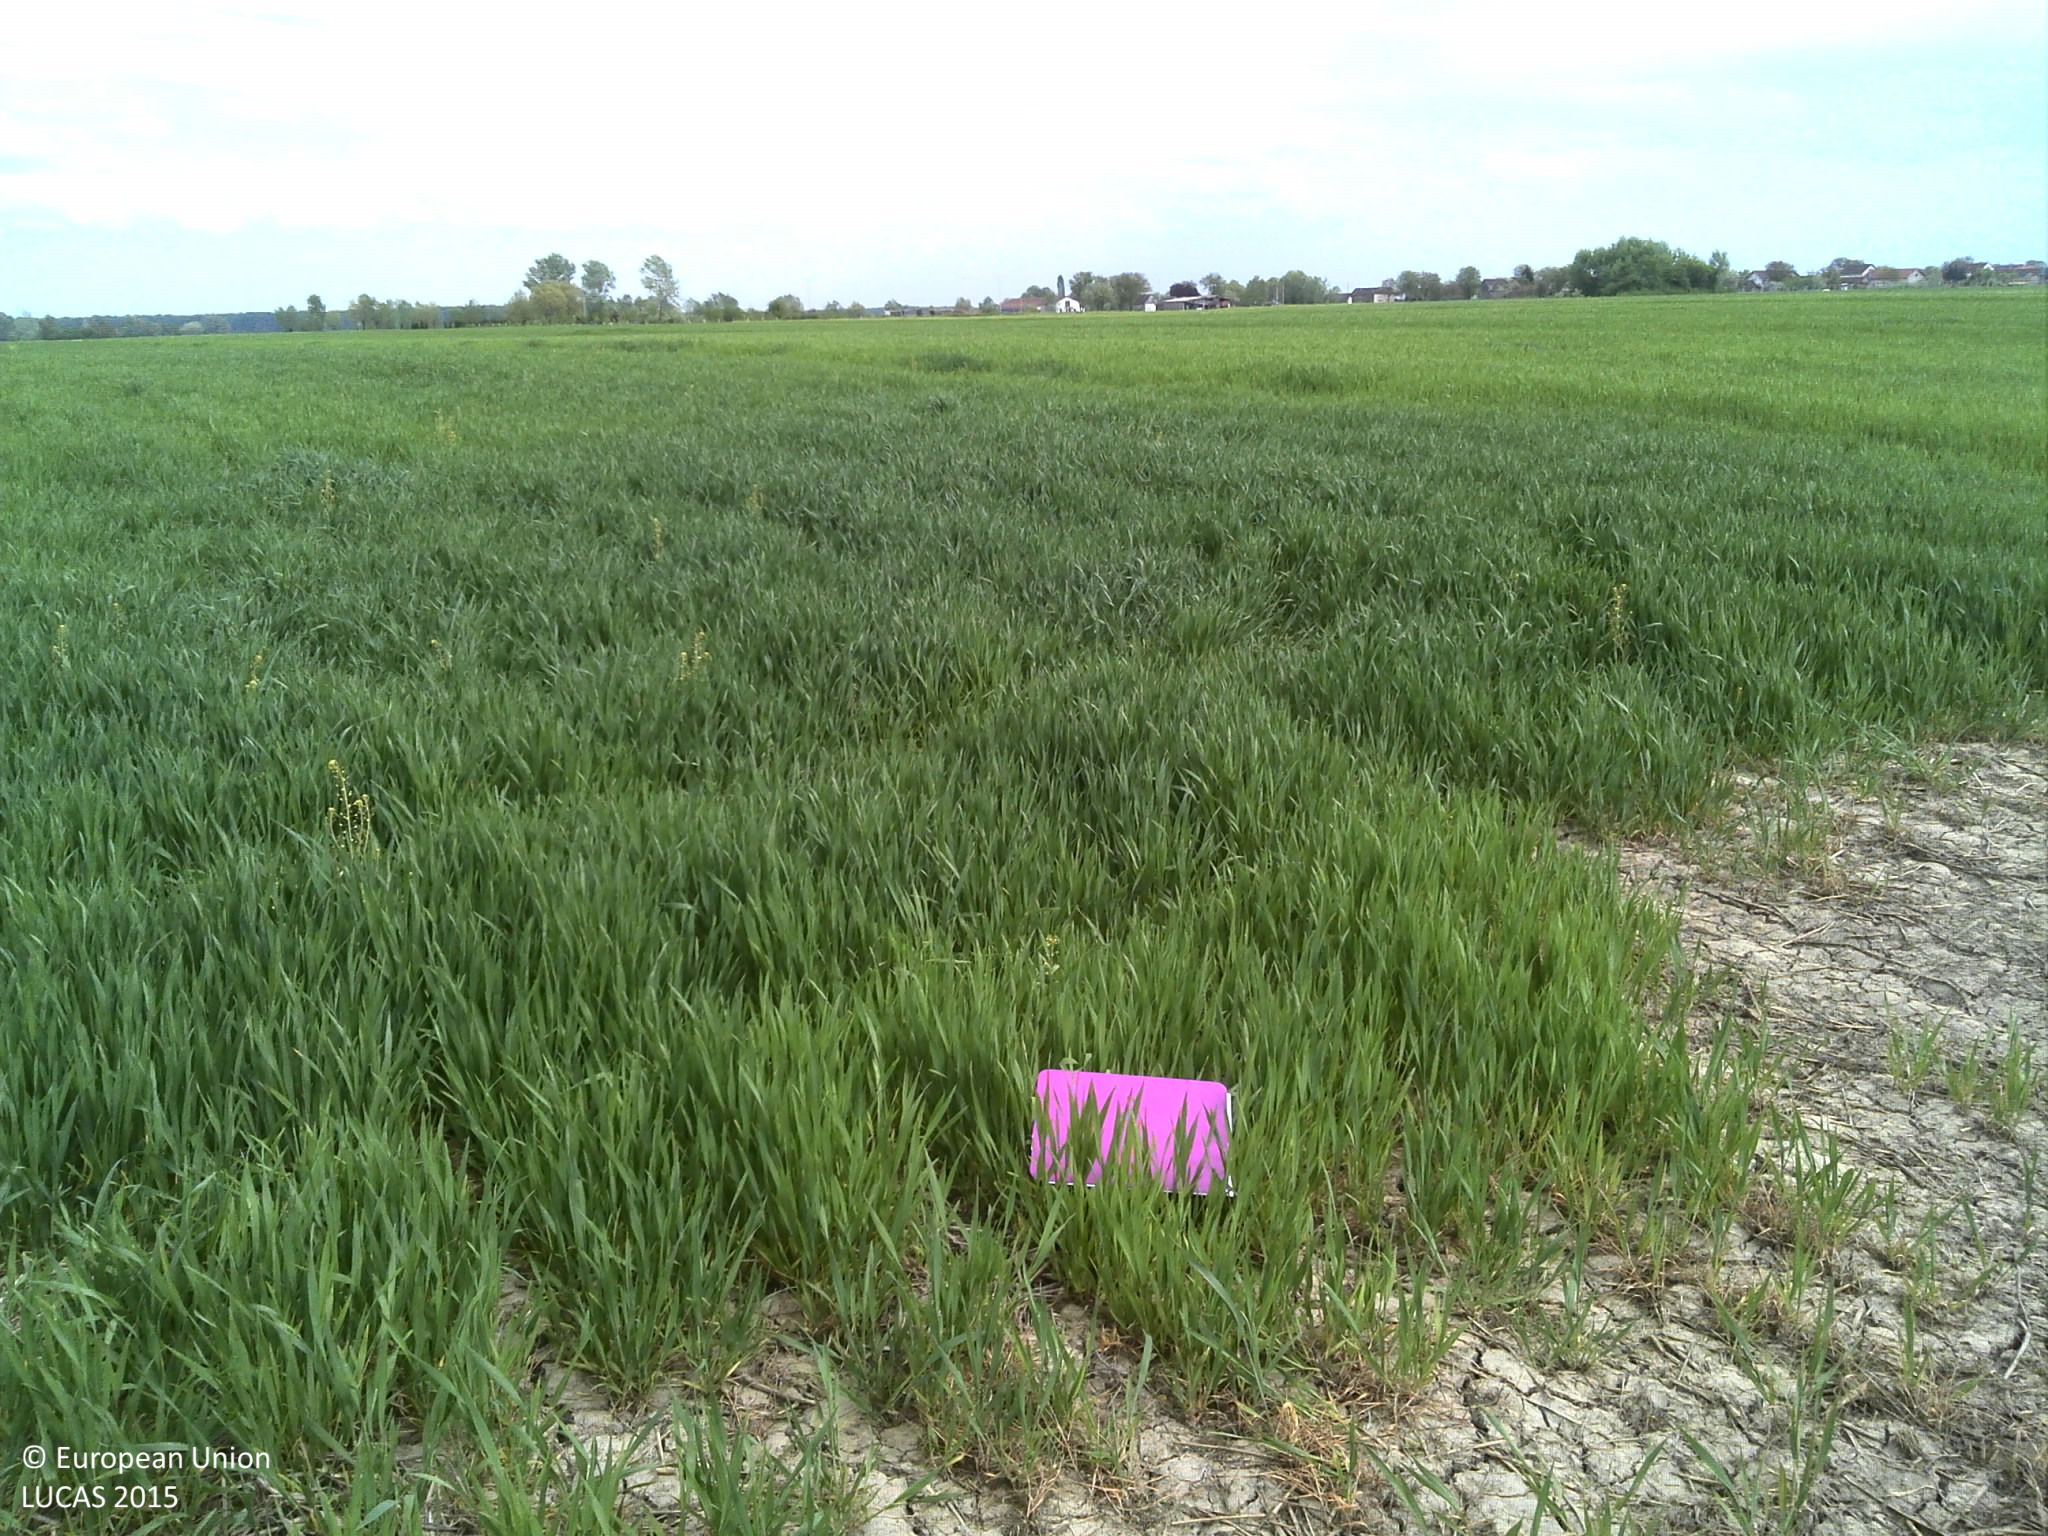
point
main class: Cropland
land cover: Common wheat
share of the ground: > 75 %
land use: Agriculture (excluding fallow land and kitchen gardens)
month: April
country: HR
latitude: 44.9989
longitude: 18.9246
